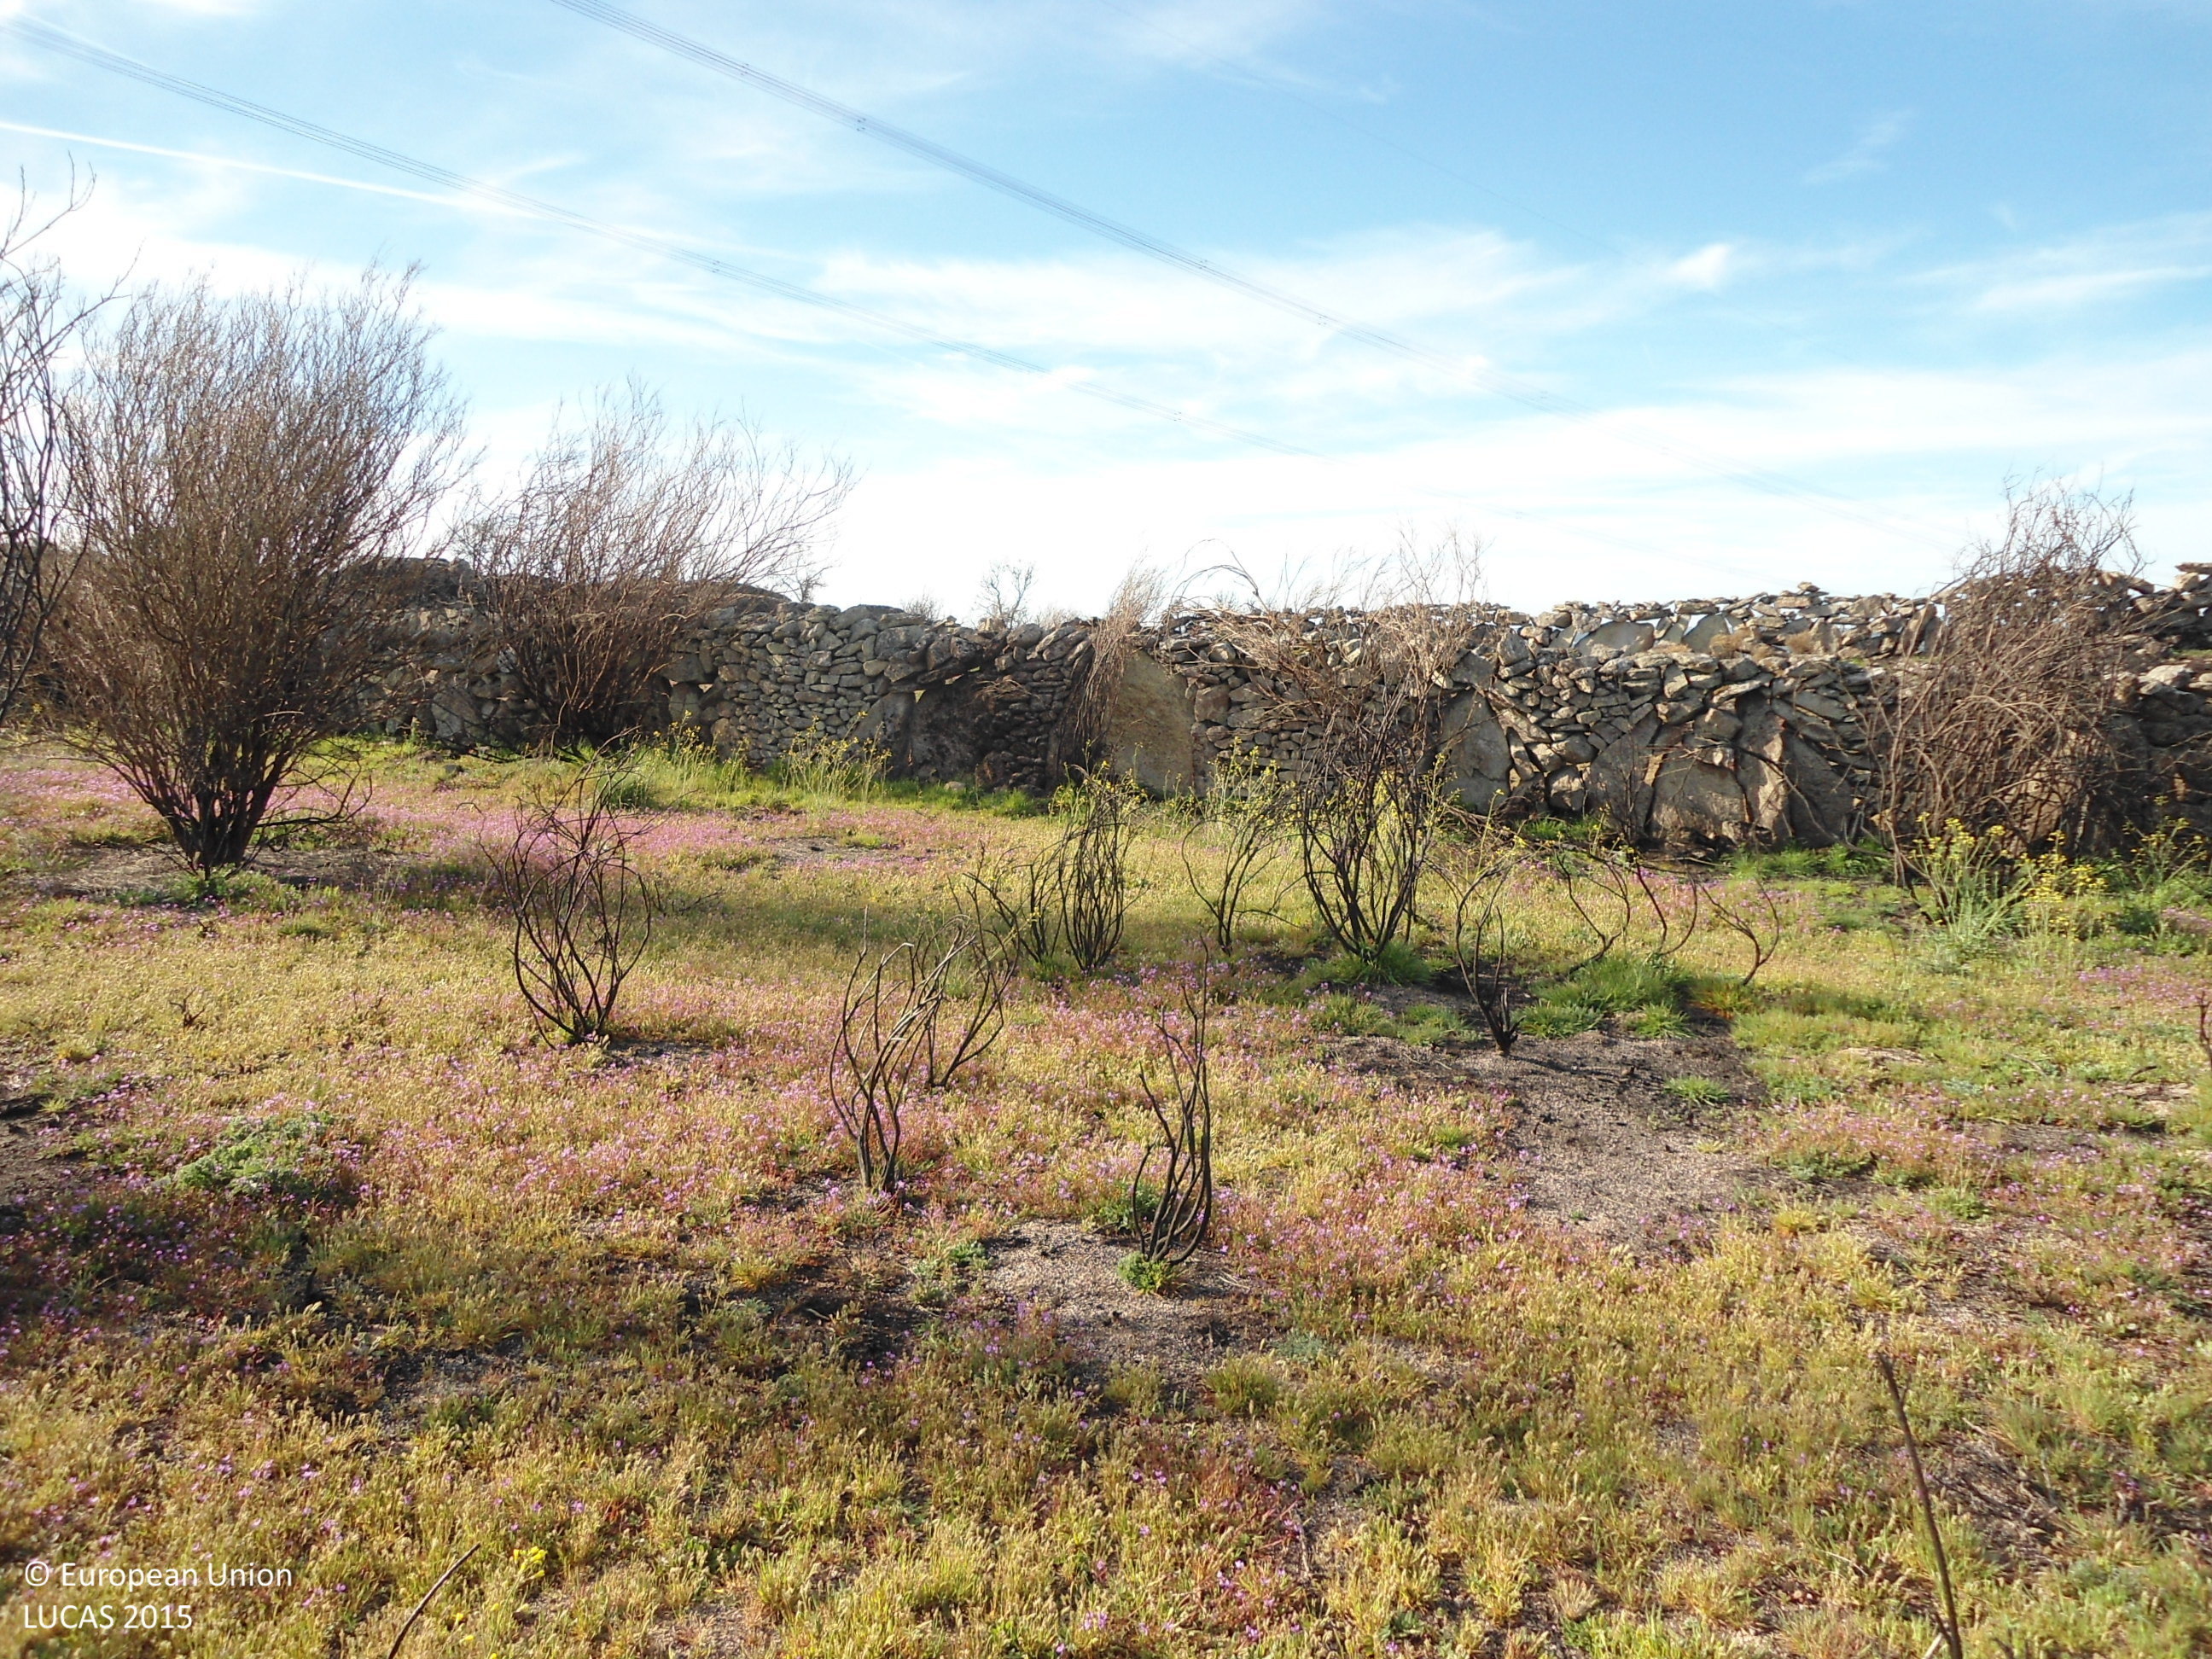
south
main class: Grassland
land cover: Grassland without tree/shrub cover
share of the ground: > 75 %
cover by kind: herbaceous plants 100 %
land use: Agriculture (excluding fallow land and kitchen gardens)
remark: Burnt area
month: April
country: ES
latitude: 41.5267
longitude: -6.0687
